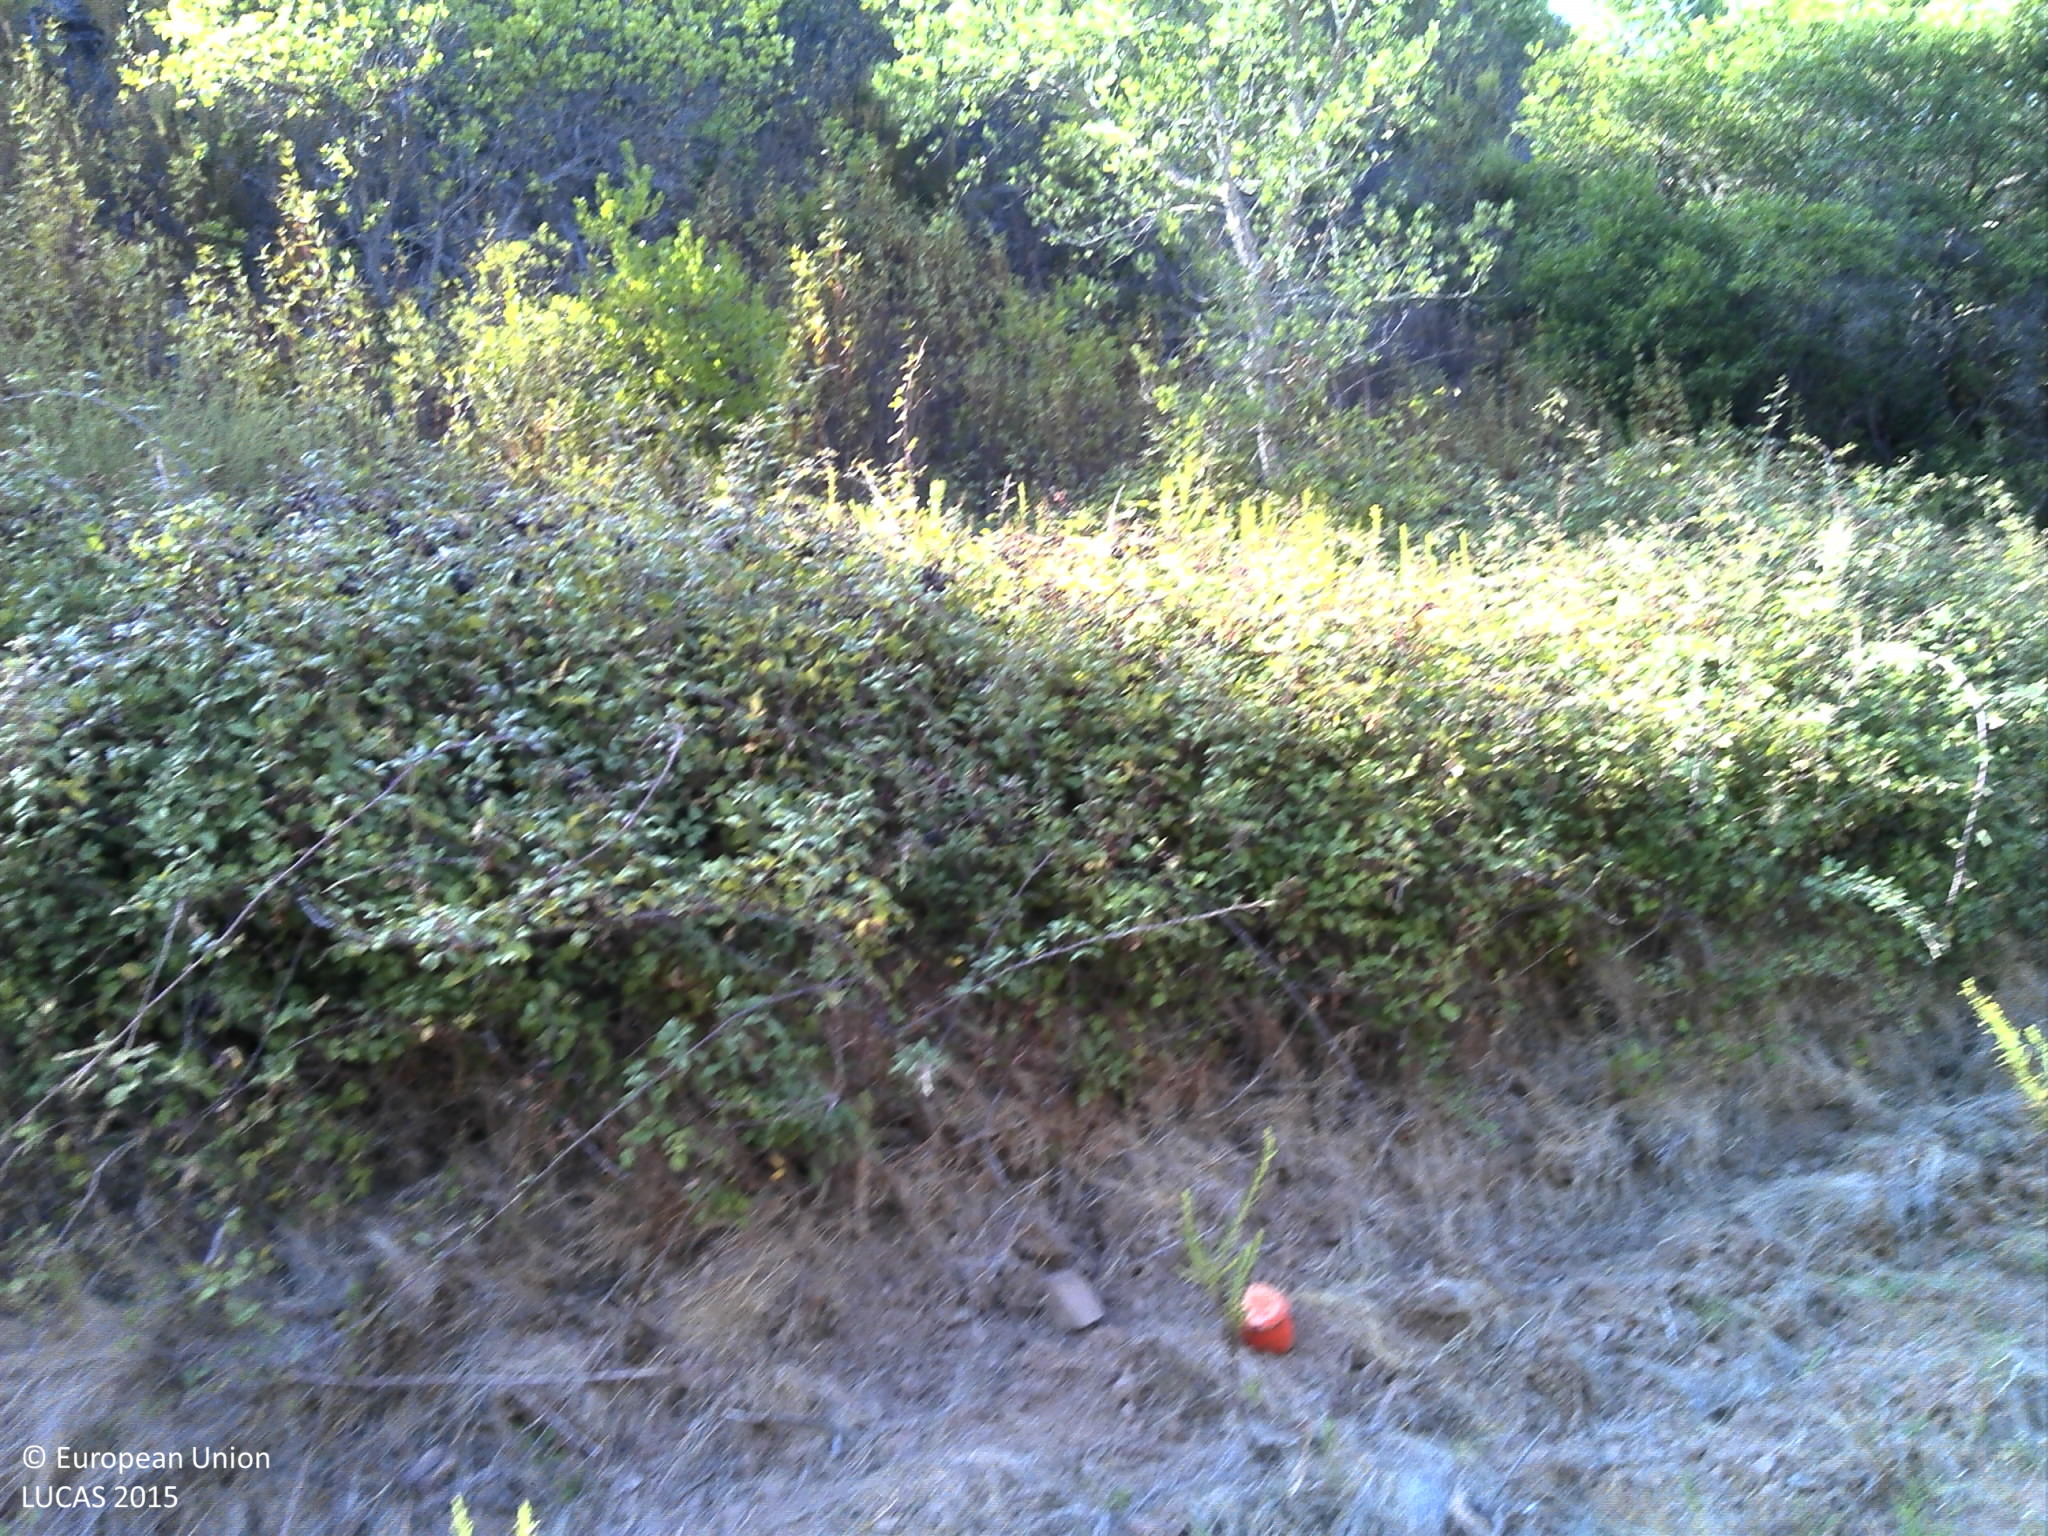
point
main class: Shrubland
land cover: Shrubland with sparse tree cover
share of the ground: 50 - 75 %
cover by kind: shrubs 70 %, unconsolidated bare surface 25 %, broadleaved forest trees 5 %
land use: Forestry
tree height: < 5 m
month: September
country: PT
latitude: 37.3892
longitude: -8.4507
